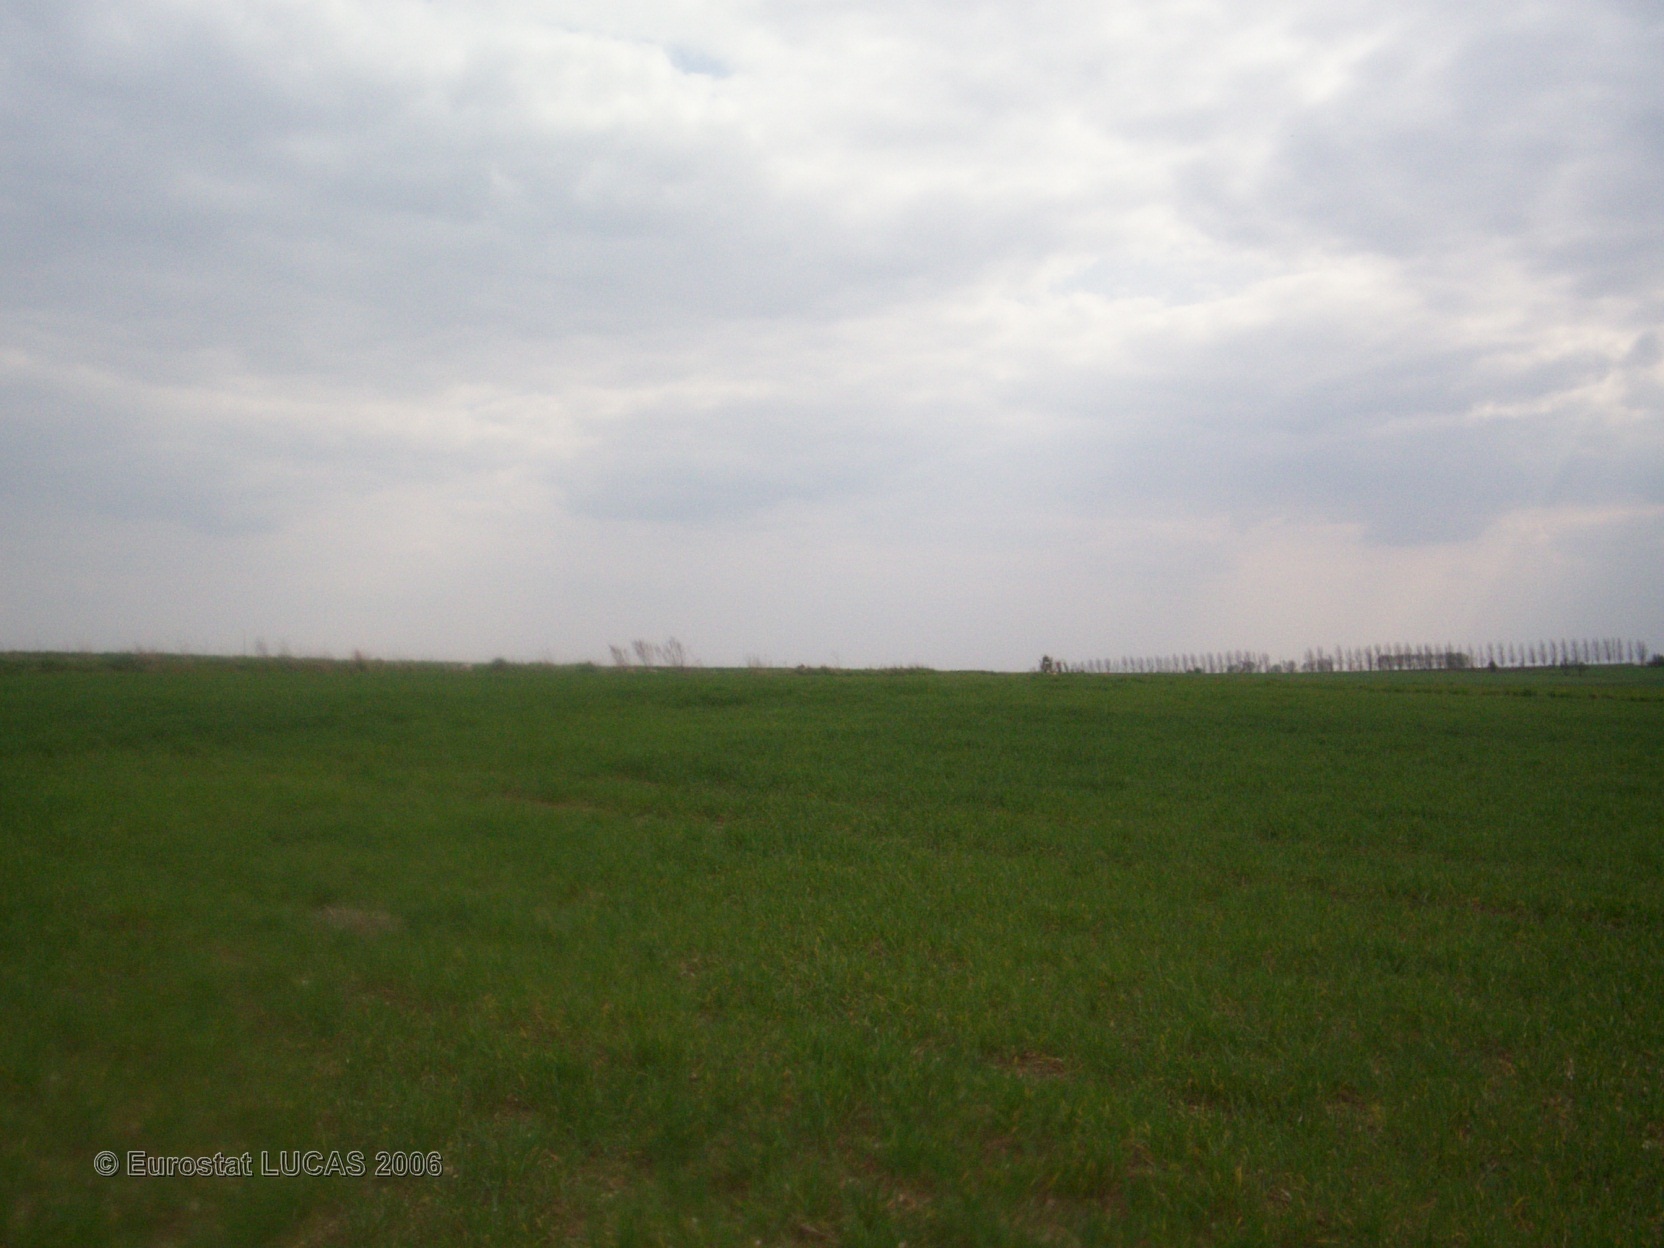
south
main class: Cropland
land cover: Common wheat
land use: Agriculture (excluding fallow land and kitchen gardens)
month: April
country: FR
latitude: 50.0341
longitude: 2.6028
